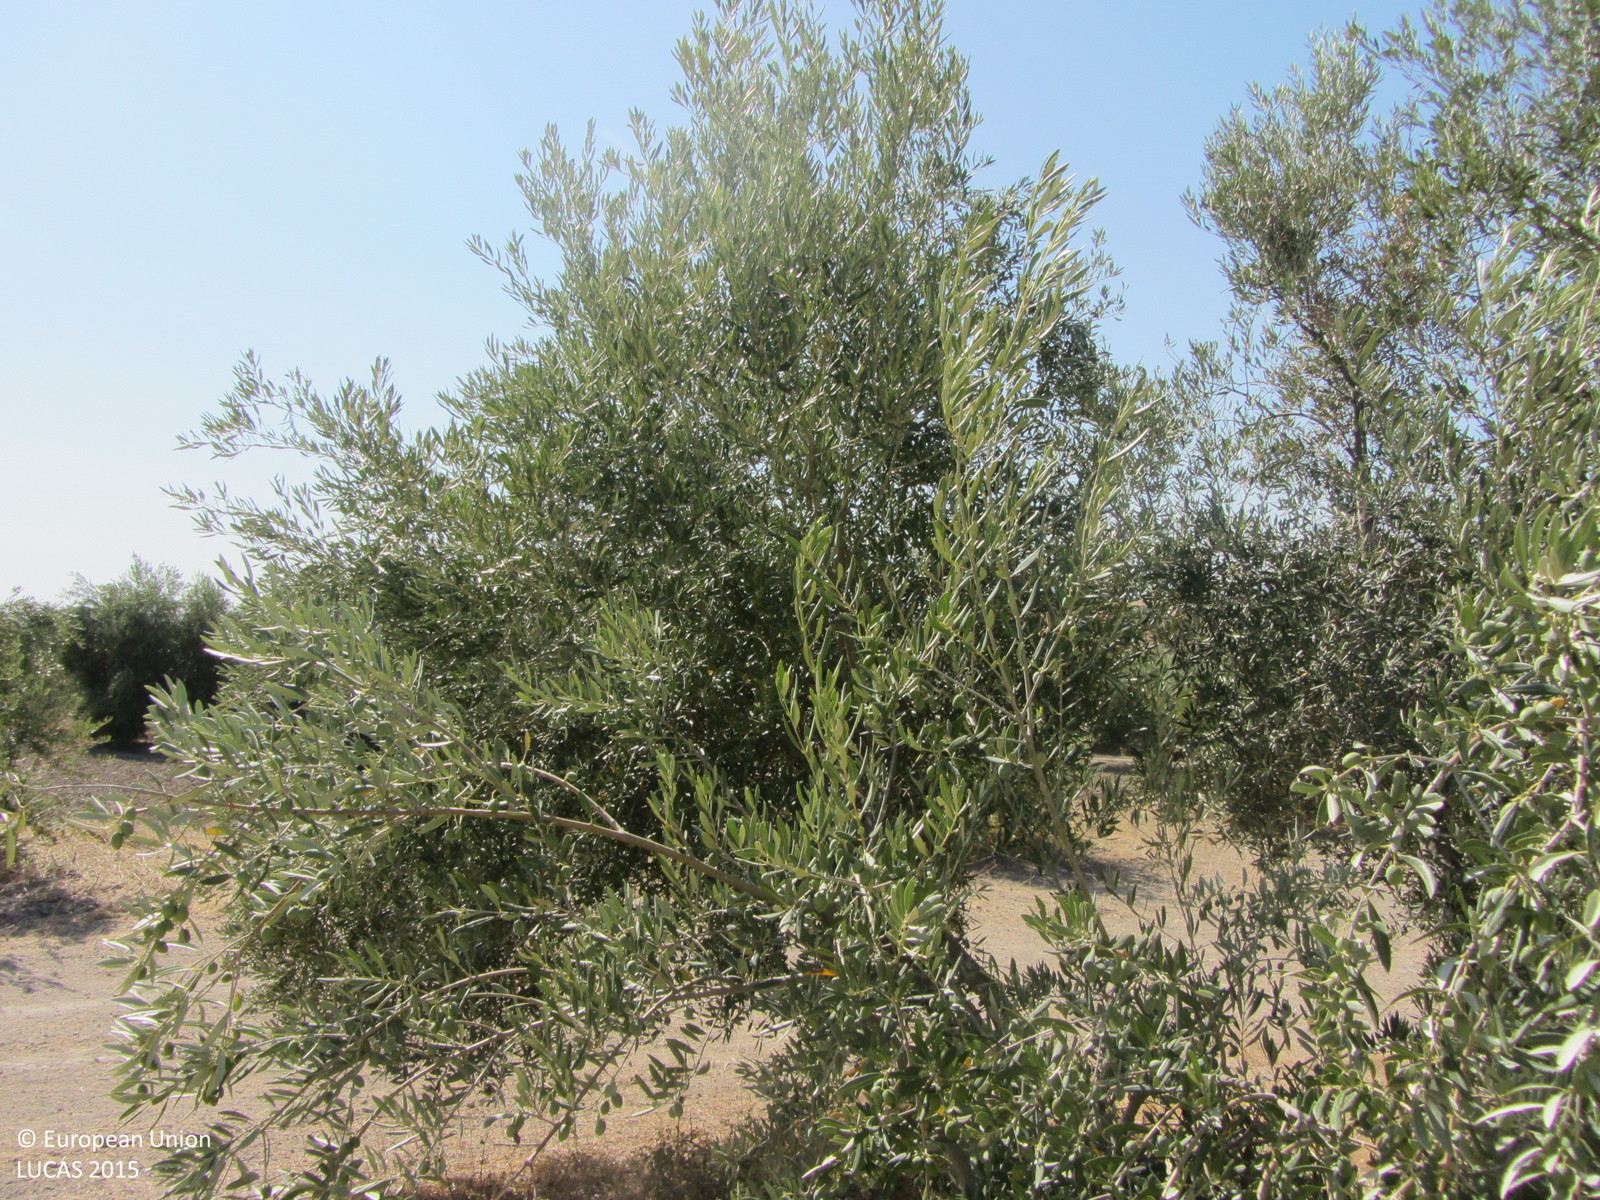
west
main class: Cropland
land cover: Olive groves
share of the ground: 25 - 50 %
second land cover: Other bare soil
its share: > 75 %
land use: Agriculture (excluding fallow land and kitchen gardens)
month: July
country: ES
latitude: 37.9761
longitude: -3.8592
